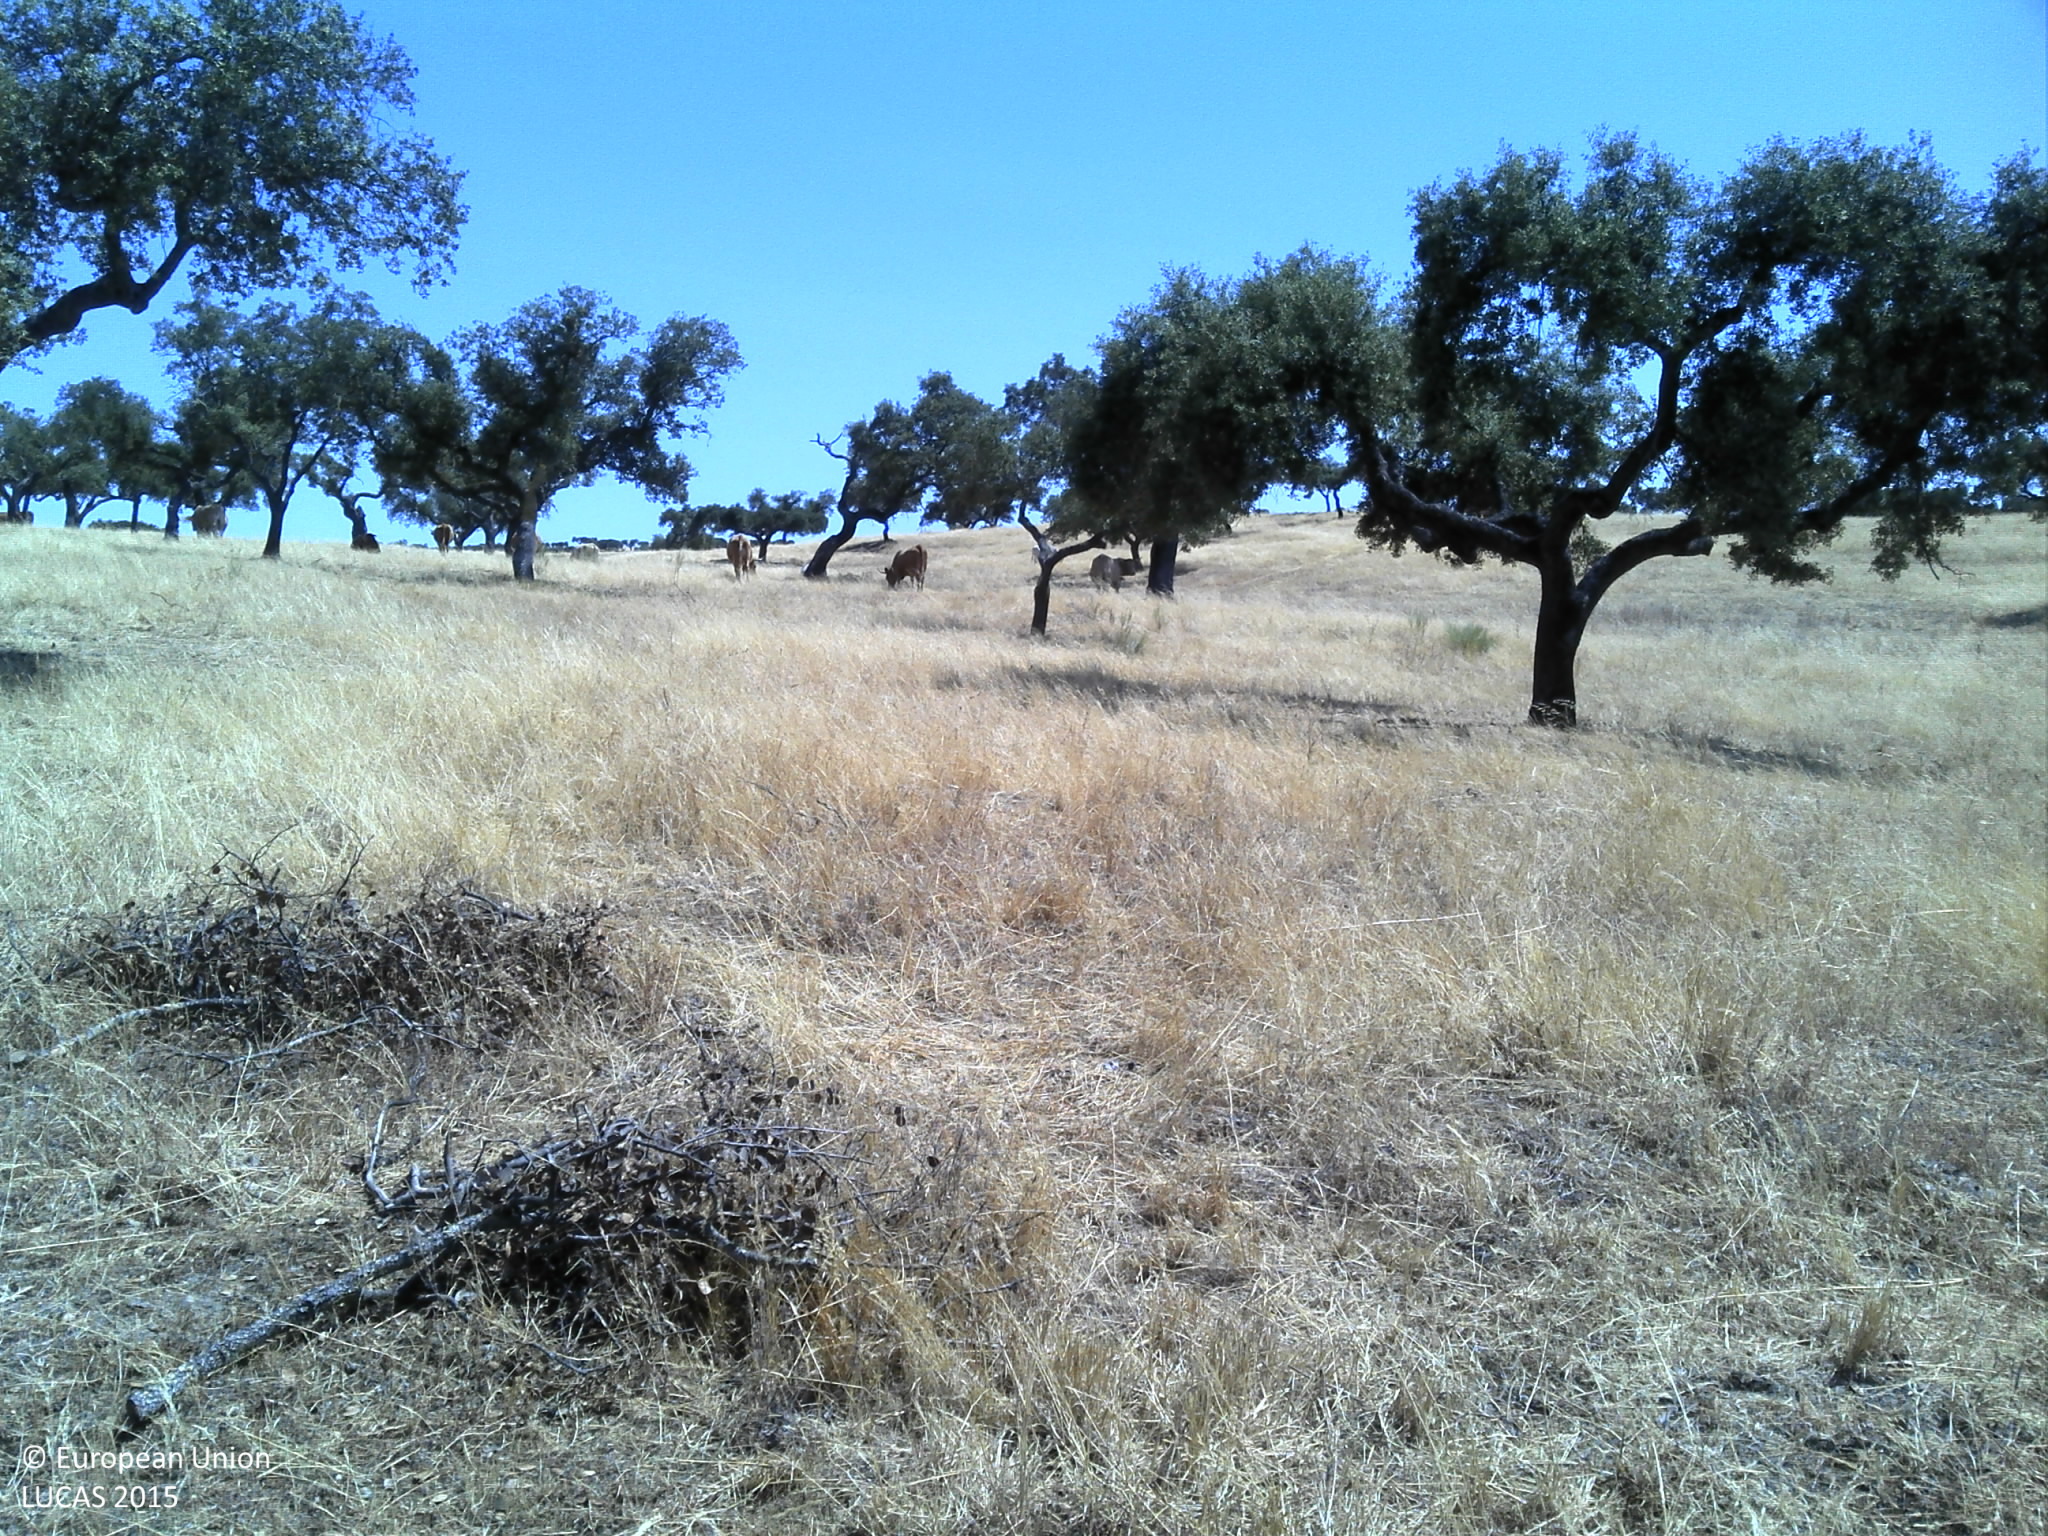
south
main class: Woodland
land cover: Broadleaved woodland
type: broadleaved evergreen forest
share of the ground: 50 - 75 %
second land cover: Grassland without tree/shrub cover
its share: 50 - 75 %
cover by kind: broadleaved forest trees 70 %, herbaceous plants 30 %
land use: Forestry
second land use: Agriculture (excluding fallow land and kitchen gardens)
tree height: > 5 m
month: July
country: PT
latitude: 38.3272
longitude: -7.2119
